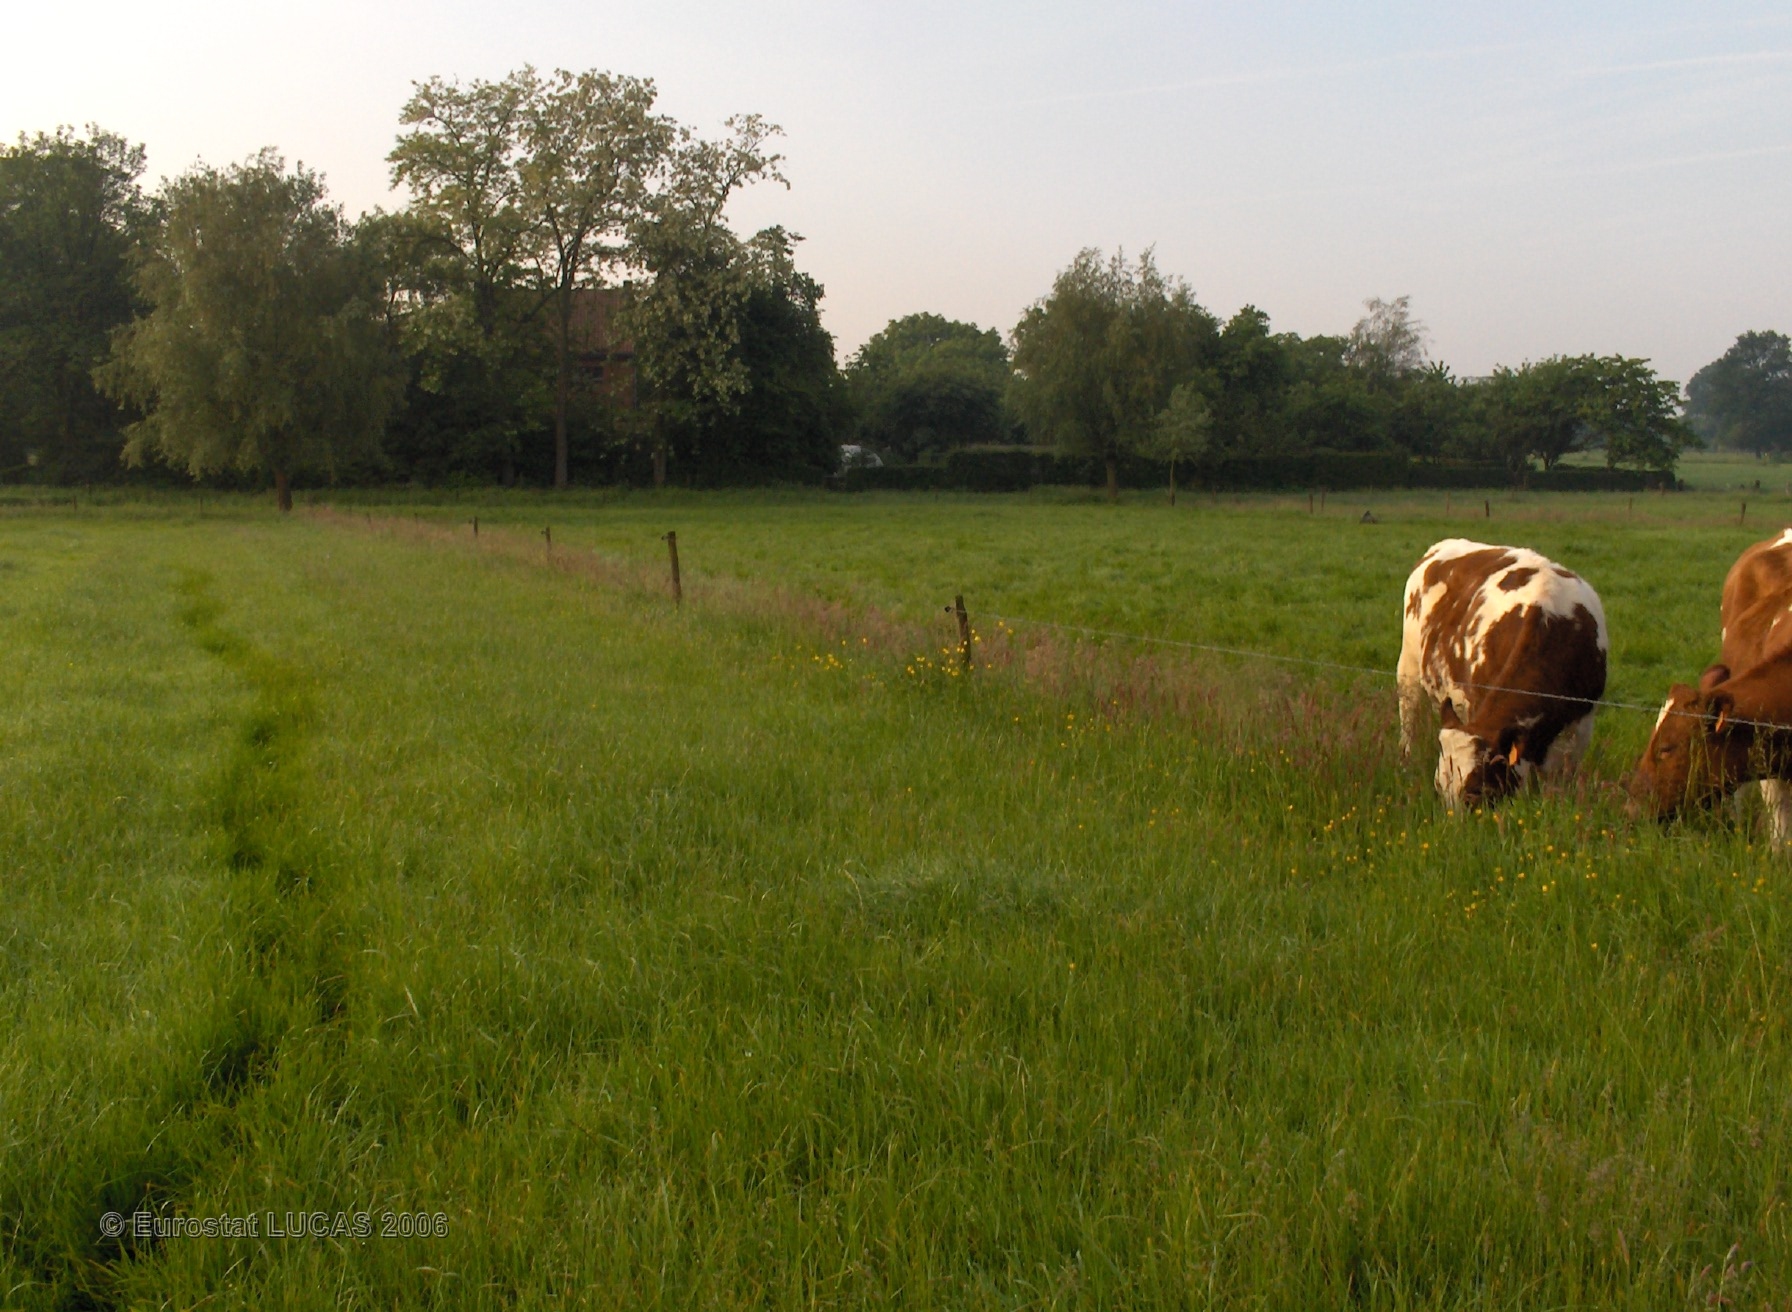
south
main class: Grassland
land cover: Grassland without tree/shrub cover
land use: Agriculture (excluding fallow land and kitchen gardens)
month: June
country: BE
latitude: 51.0005
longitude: 5.1668
